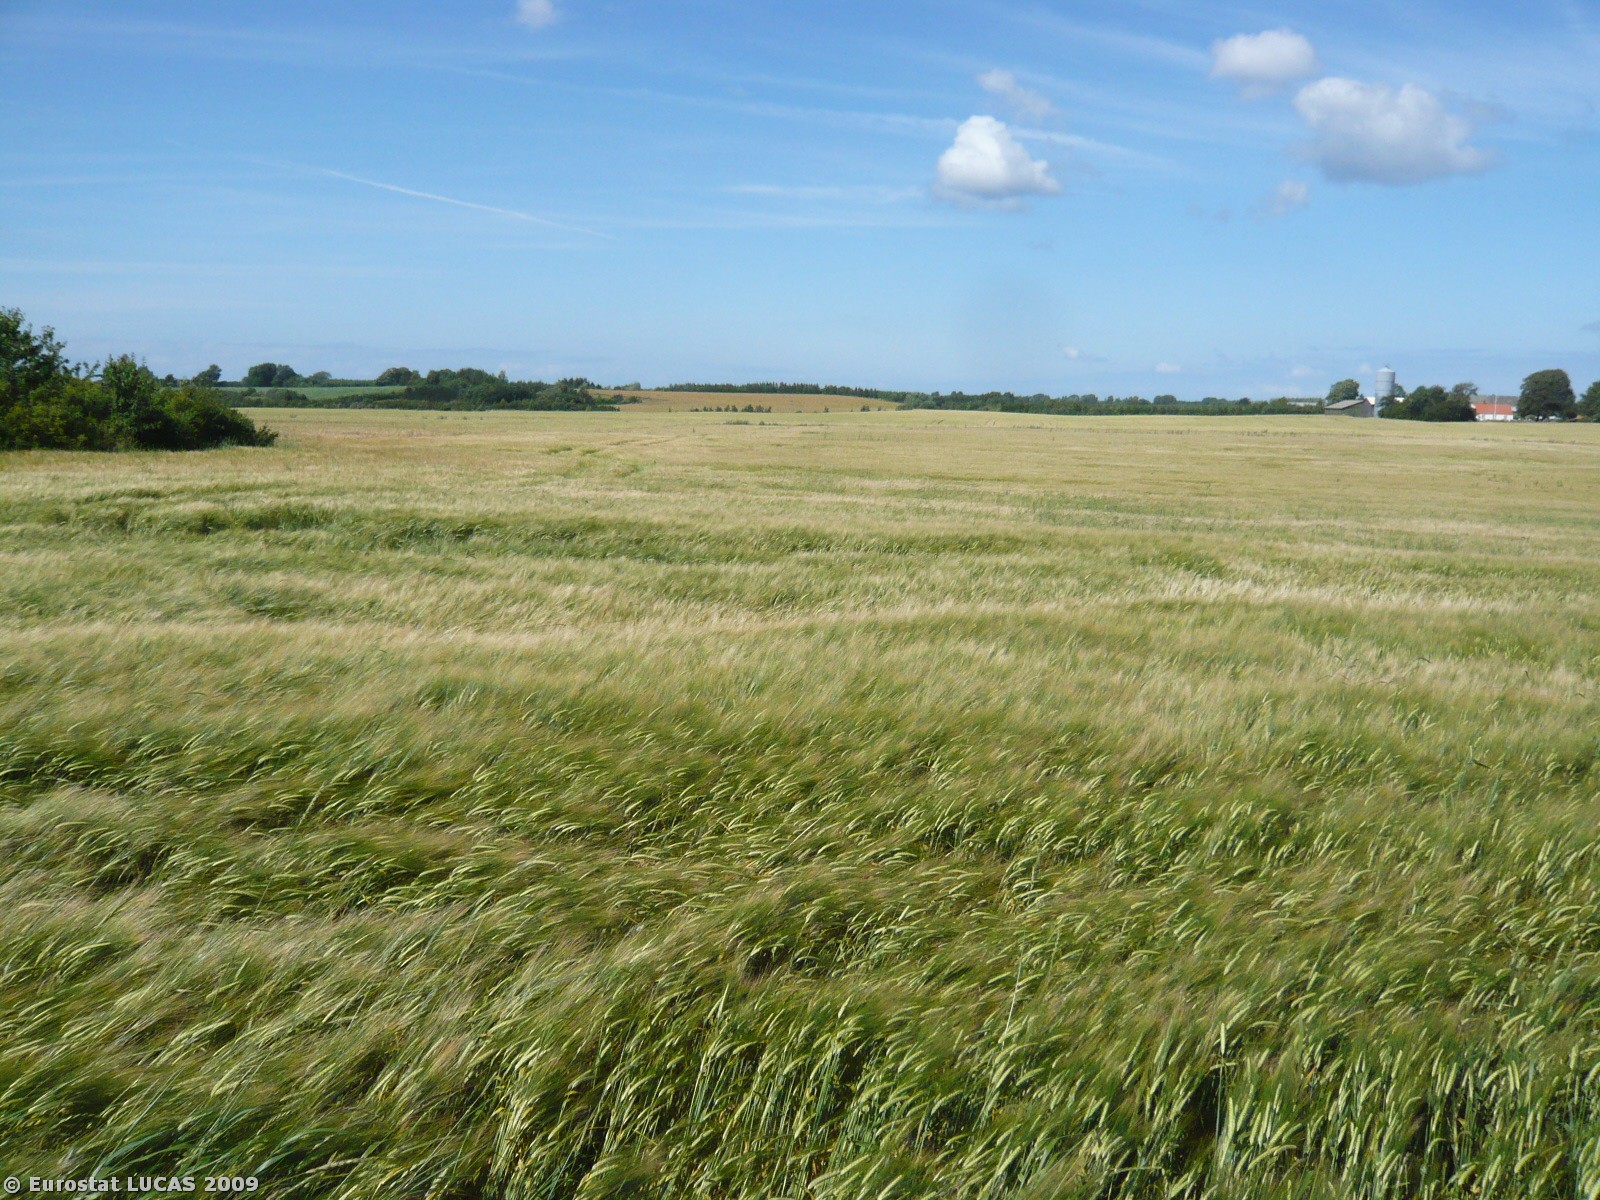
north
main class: Cropland
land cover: Barley
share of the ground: > 75 %
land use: Agriculture (excluding fallow land and kitchen gardens)
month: July
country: DK
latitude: 55.6974
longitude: 11.1285
